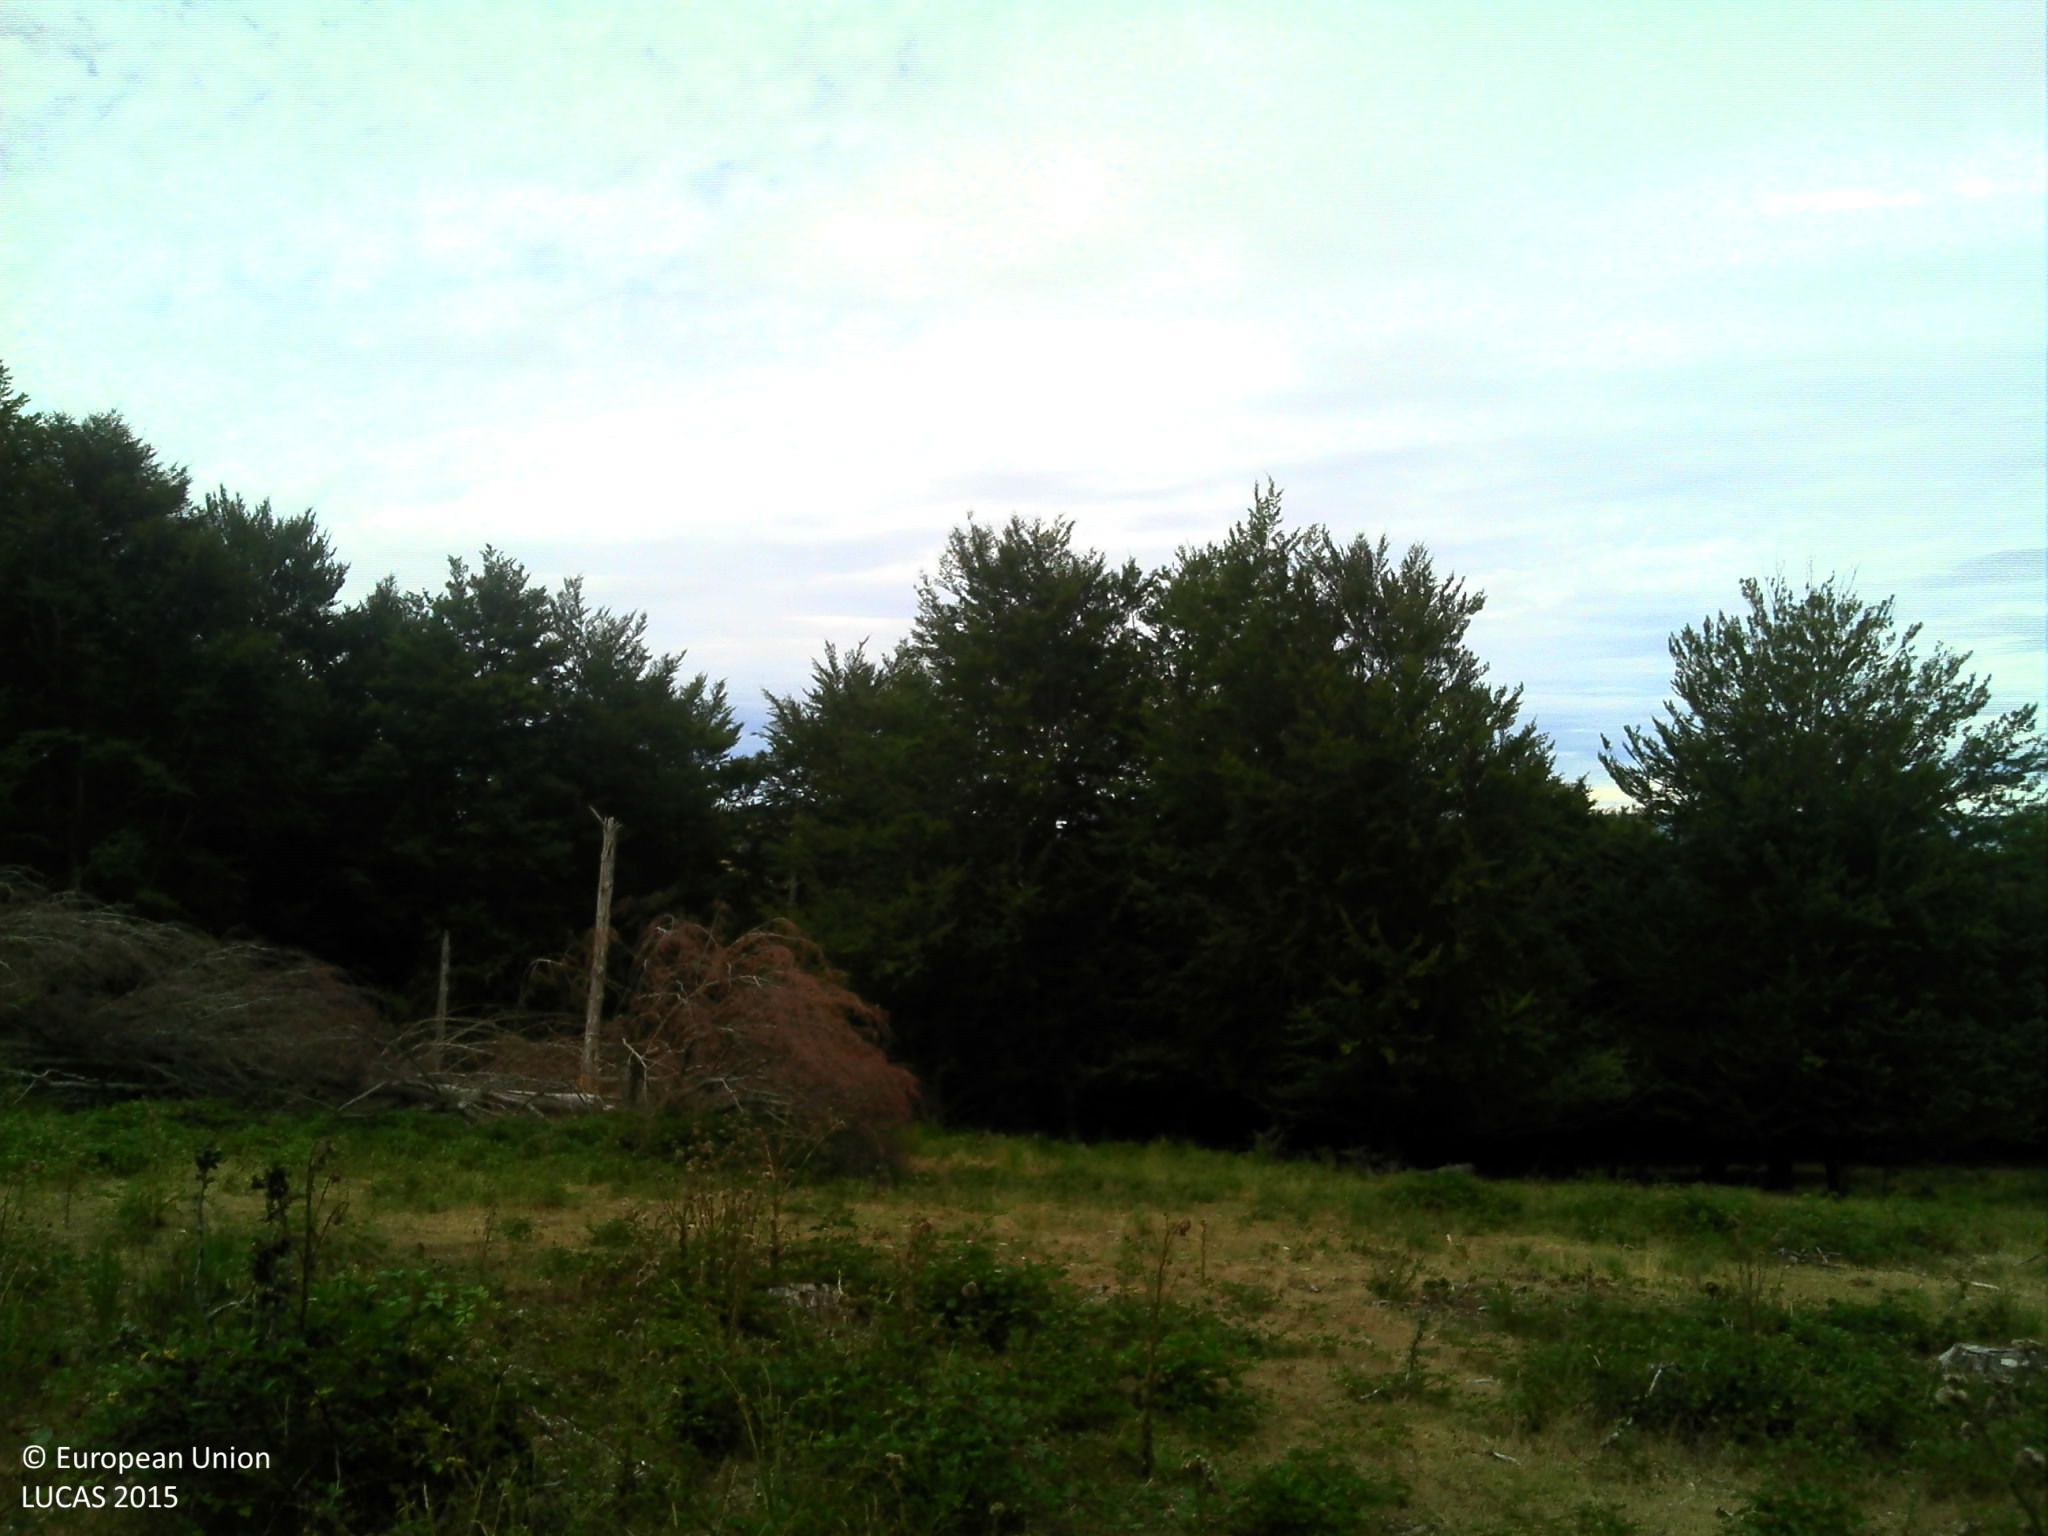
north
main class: Grassland
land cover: Grassland with sparse tree/shrub cover
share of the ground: > 75 %
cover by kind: herbaceous plants 85 %, shrubs 10 %, broadleaved forest trees 5 %
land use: Agriculture (excluding fallow land and kitchen gardens)
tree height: < 5 m
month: July
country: FR
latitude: 44.8842
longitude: 3.1537
